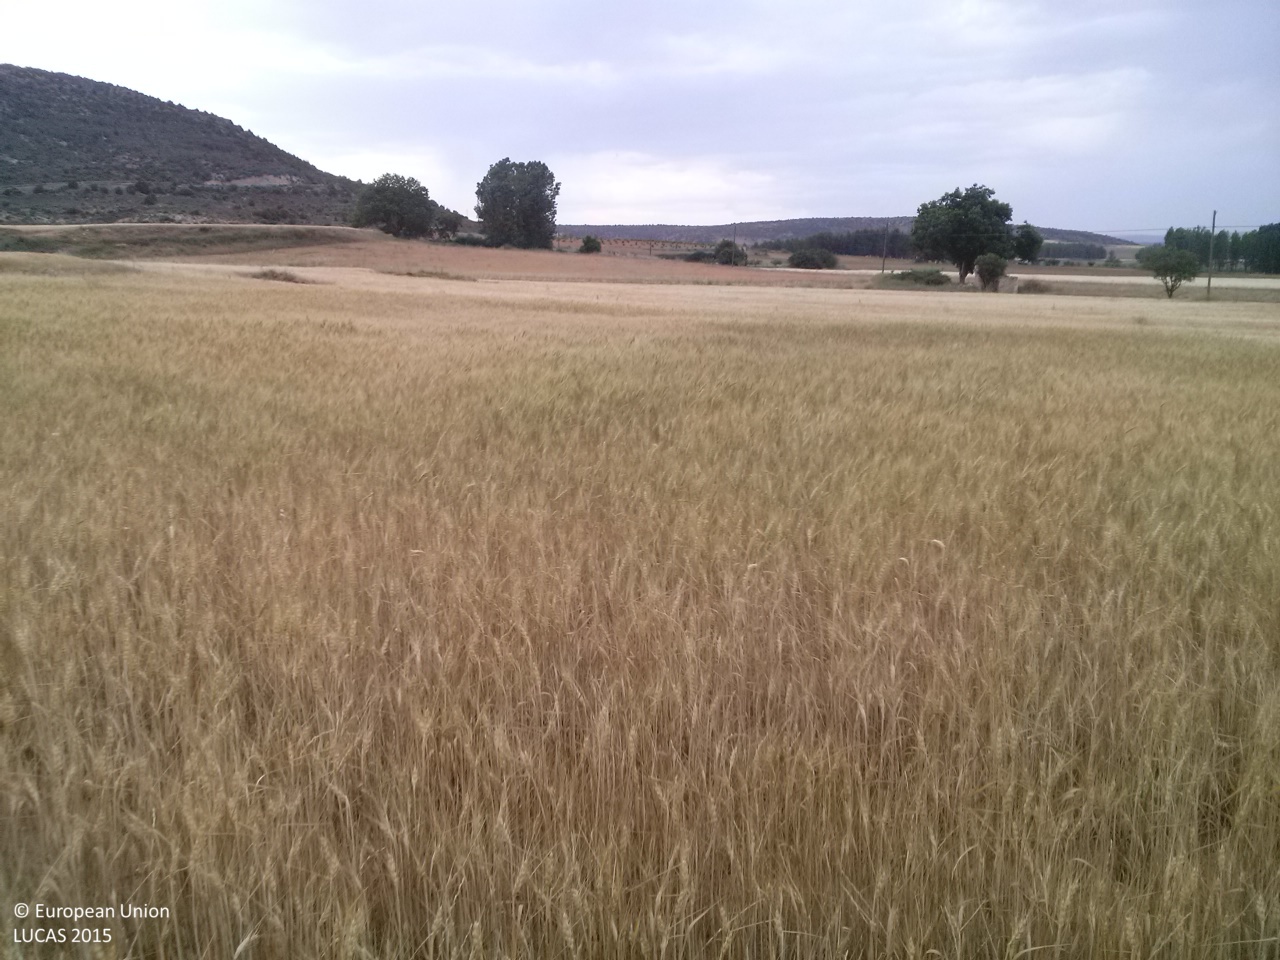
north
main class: Cropland
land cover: Barley
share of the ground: > 75 %
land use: Agriculture (excluding fallow land and kitchen gardens)
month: June
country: ES
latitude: 39.9104
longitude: -1.8616
